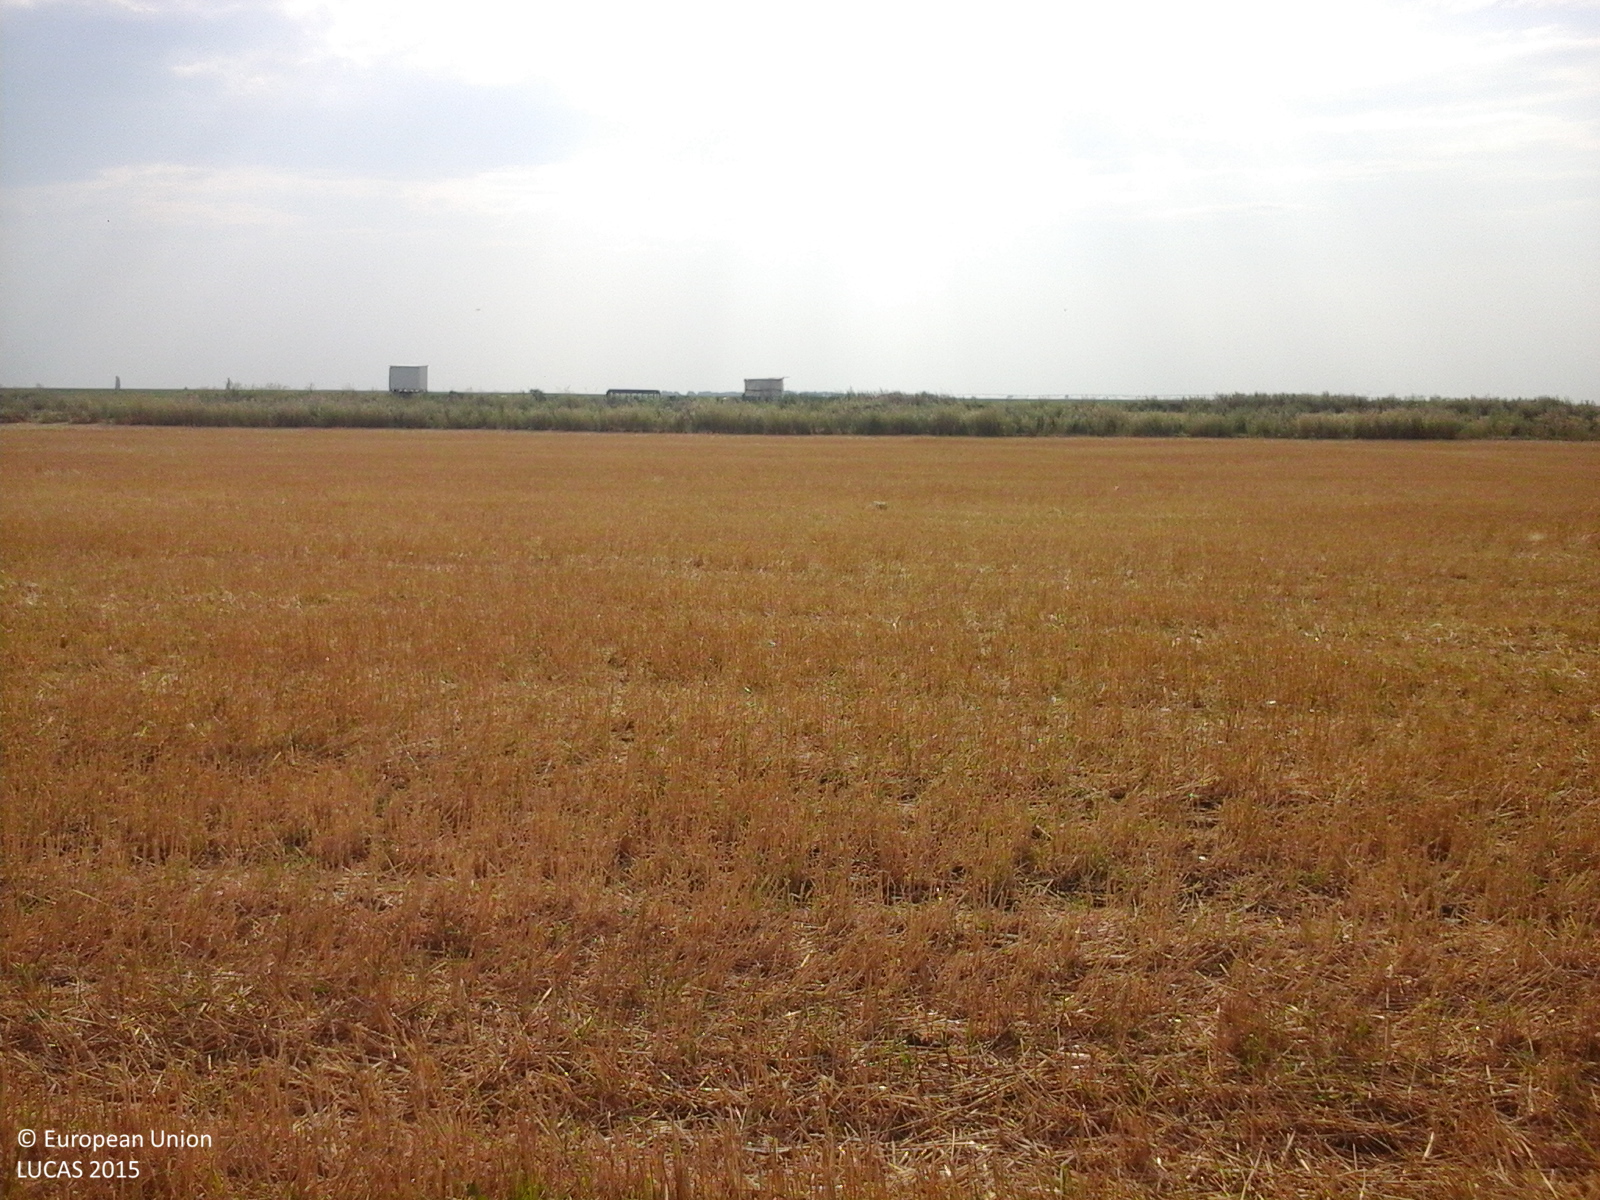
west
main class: Cropland
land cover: Maize
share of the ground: > 75 %
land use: Agriculture (excluding fallow land and kitchen gardens)
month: August
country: RO
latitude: 45.0504
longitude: 27.6629
